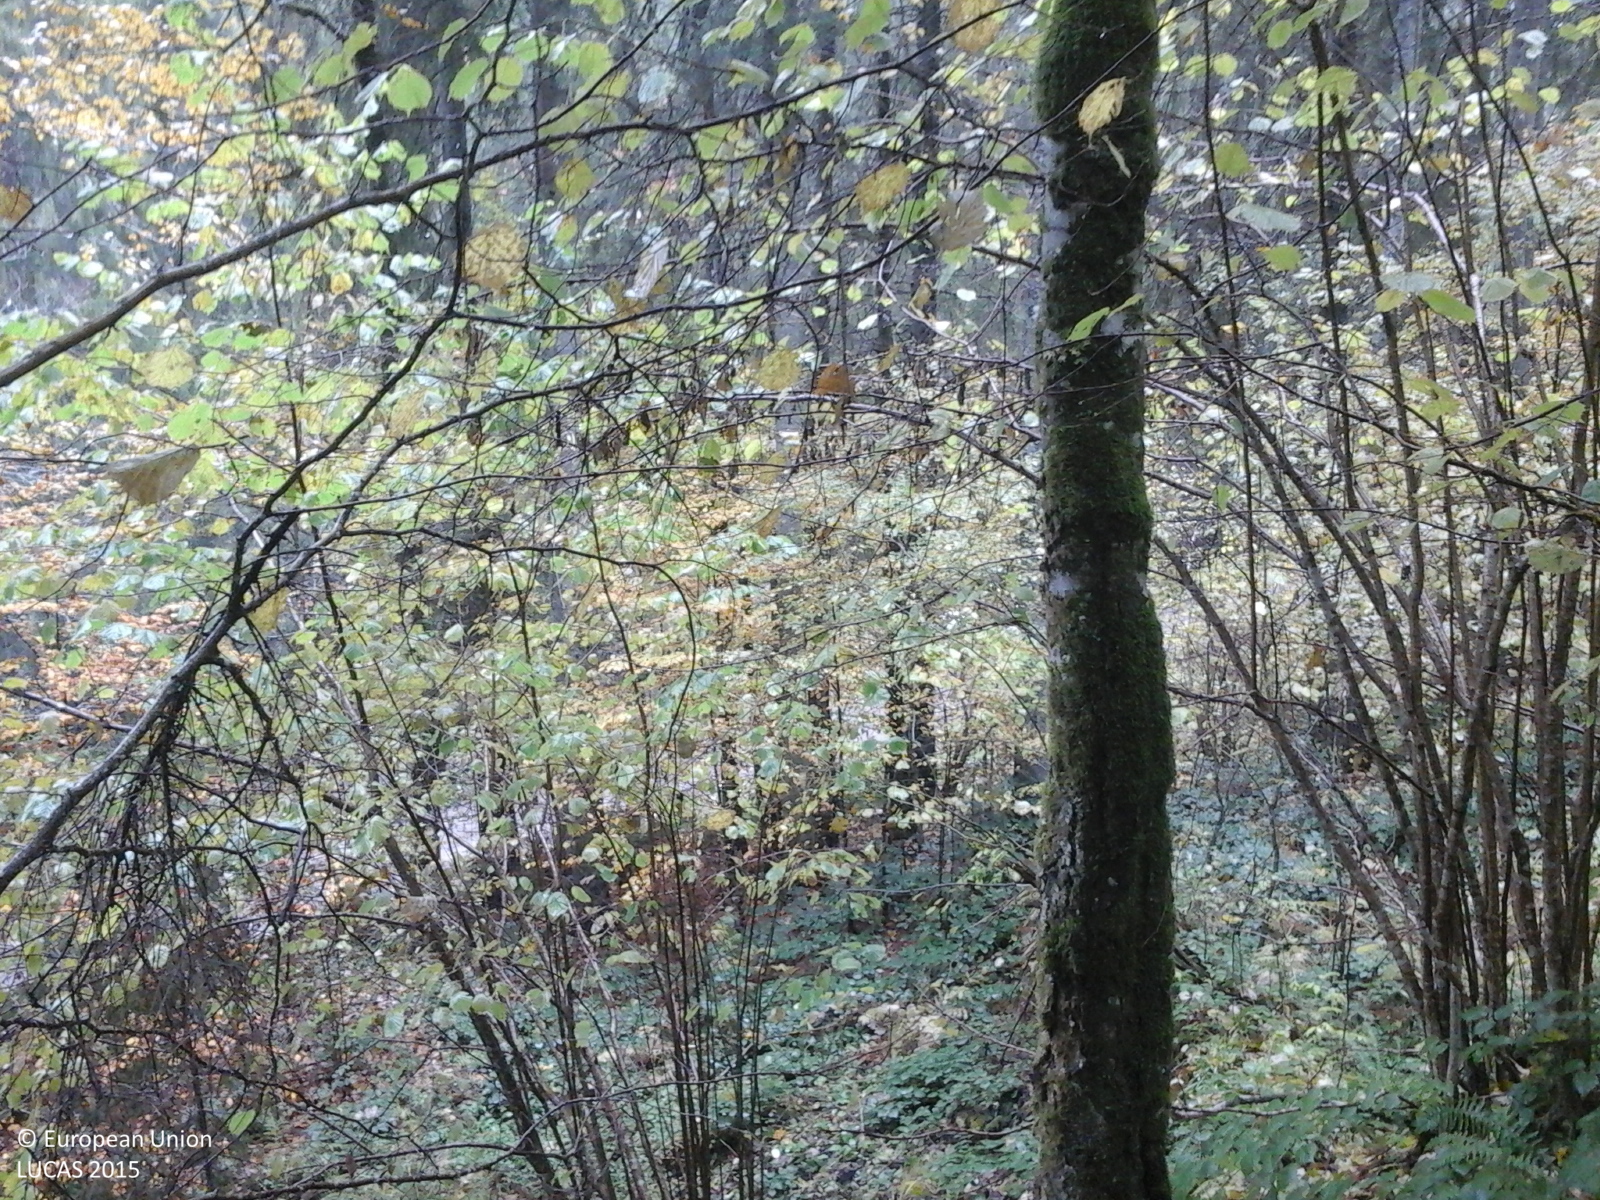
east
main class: Woodland
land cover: Other mixed woodland
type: alpine coniferous forest
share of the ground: > 75 %
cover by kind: coniferous forest trees 70 %, broadleaved forest trees 30 %
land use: Forestry
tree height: > 5 m
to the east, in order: Other mixed woodland; Ditches and canals; Paved roads, cycling and walking lanes; Other mixed woodland; Rivers and streams; Other mixed woodland
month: October
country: RO
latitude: 46.8789
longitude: 25.1272
